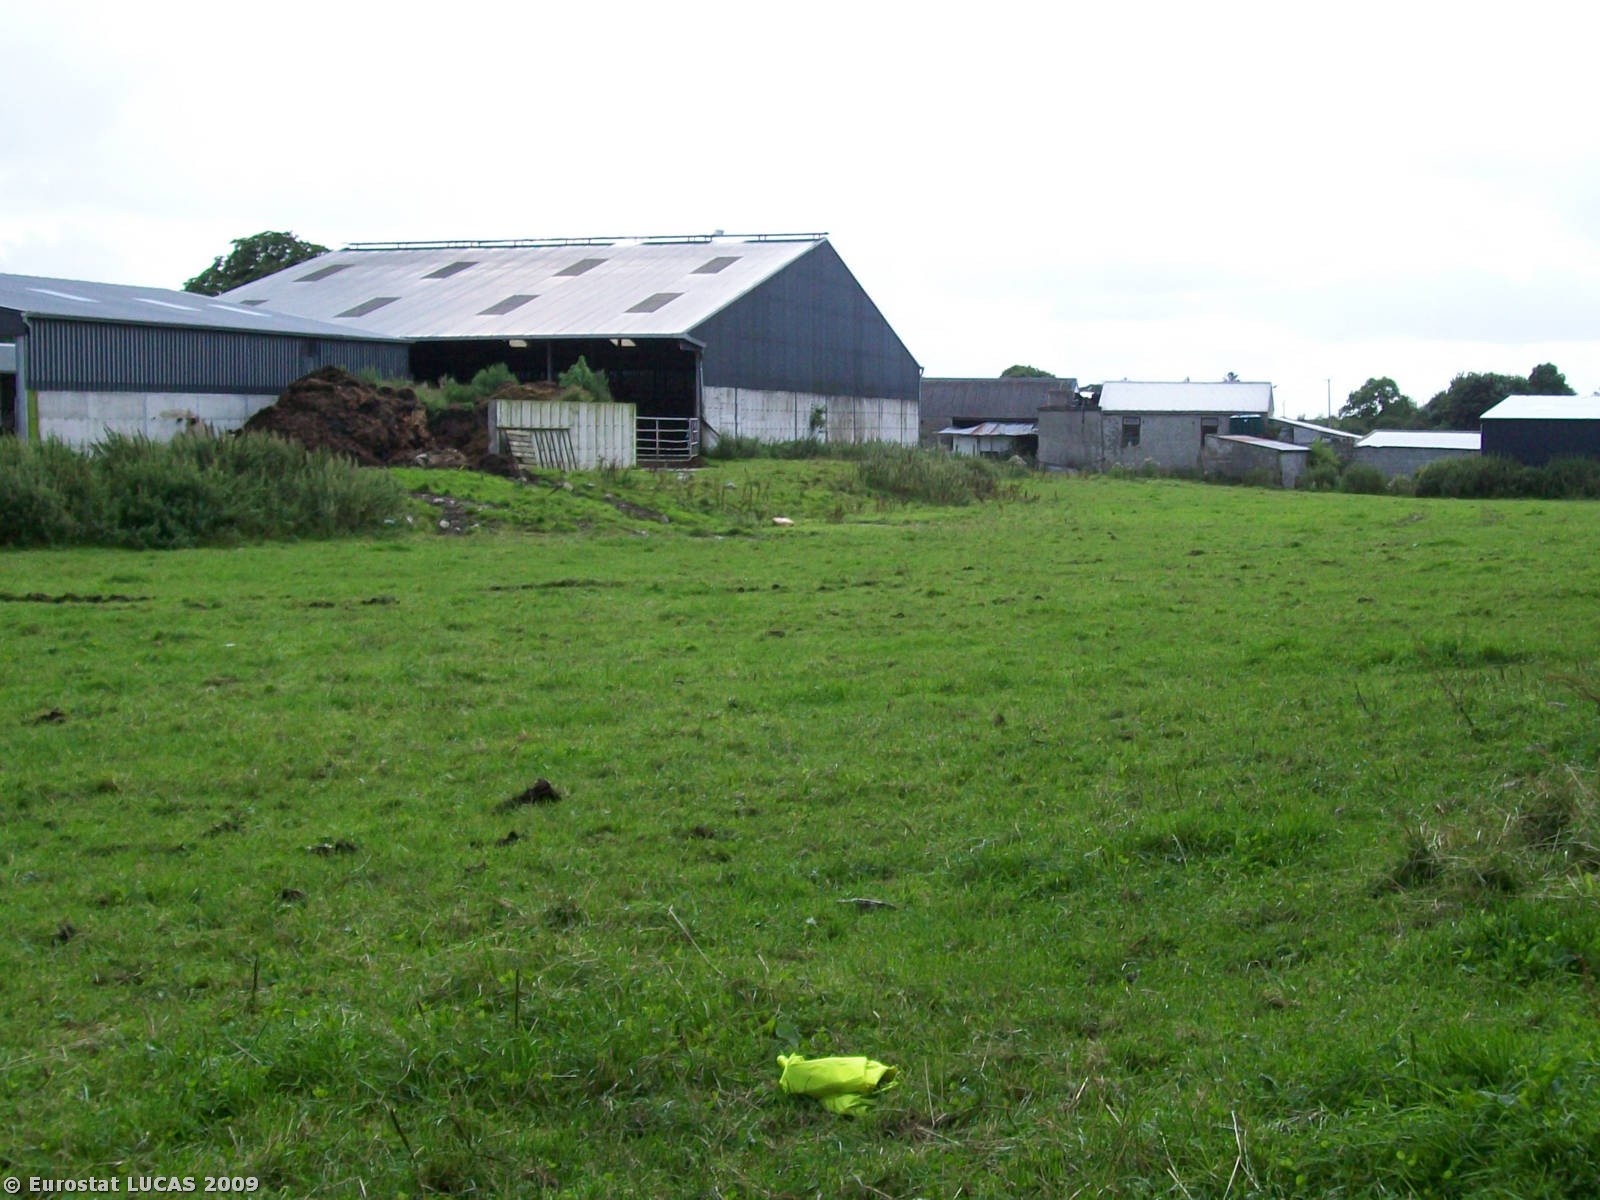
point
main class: Grassland
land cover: Grassland without tree/shrub cover
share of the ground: > 75 %
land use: Agriculture (excluding fallow land and kitchen gardens)
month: August
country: IE
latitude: 53.1200
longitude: -8.7461
